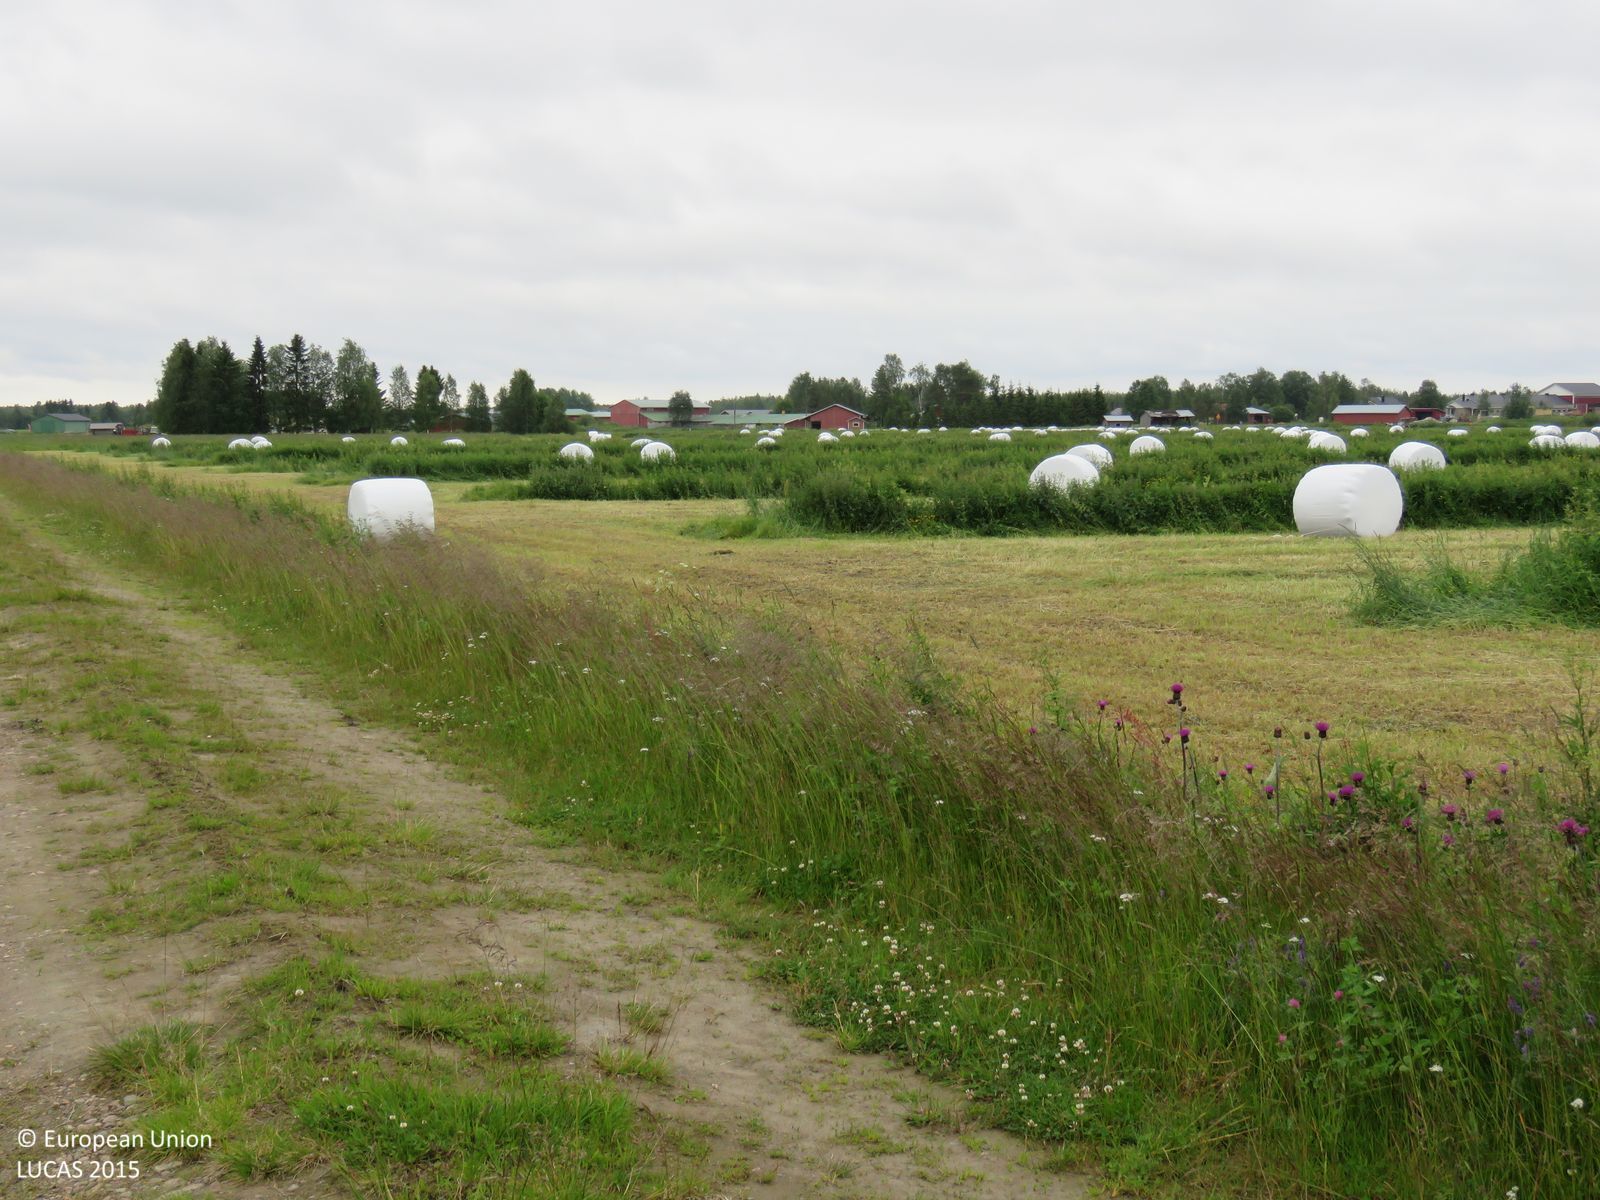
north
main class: Cropland
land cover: Temporary grasslands
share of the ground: > 75 %
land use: Agriculture (excluding fallow land and kitchen gardens)
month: July
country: FI
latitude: 64.4072
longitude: 26.4004
